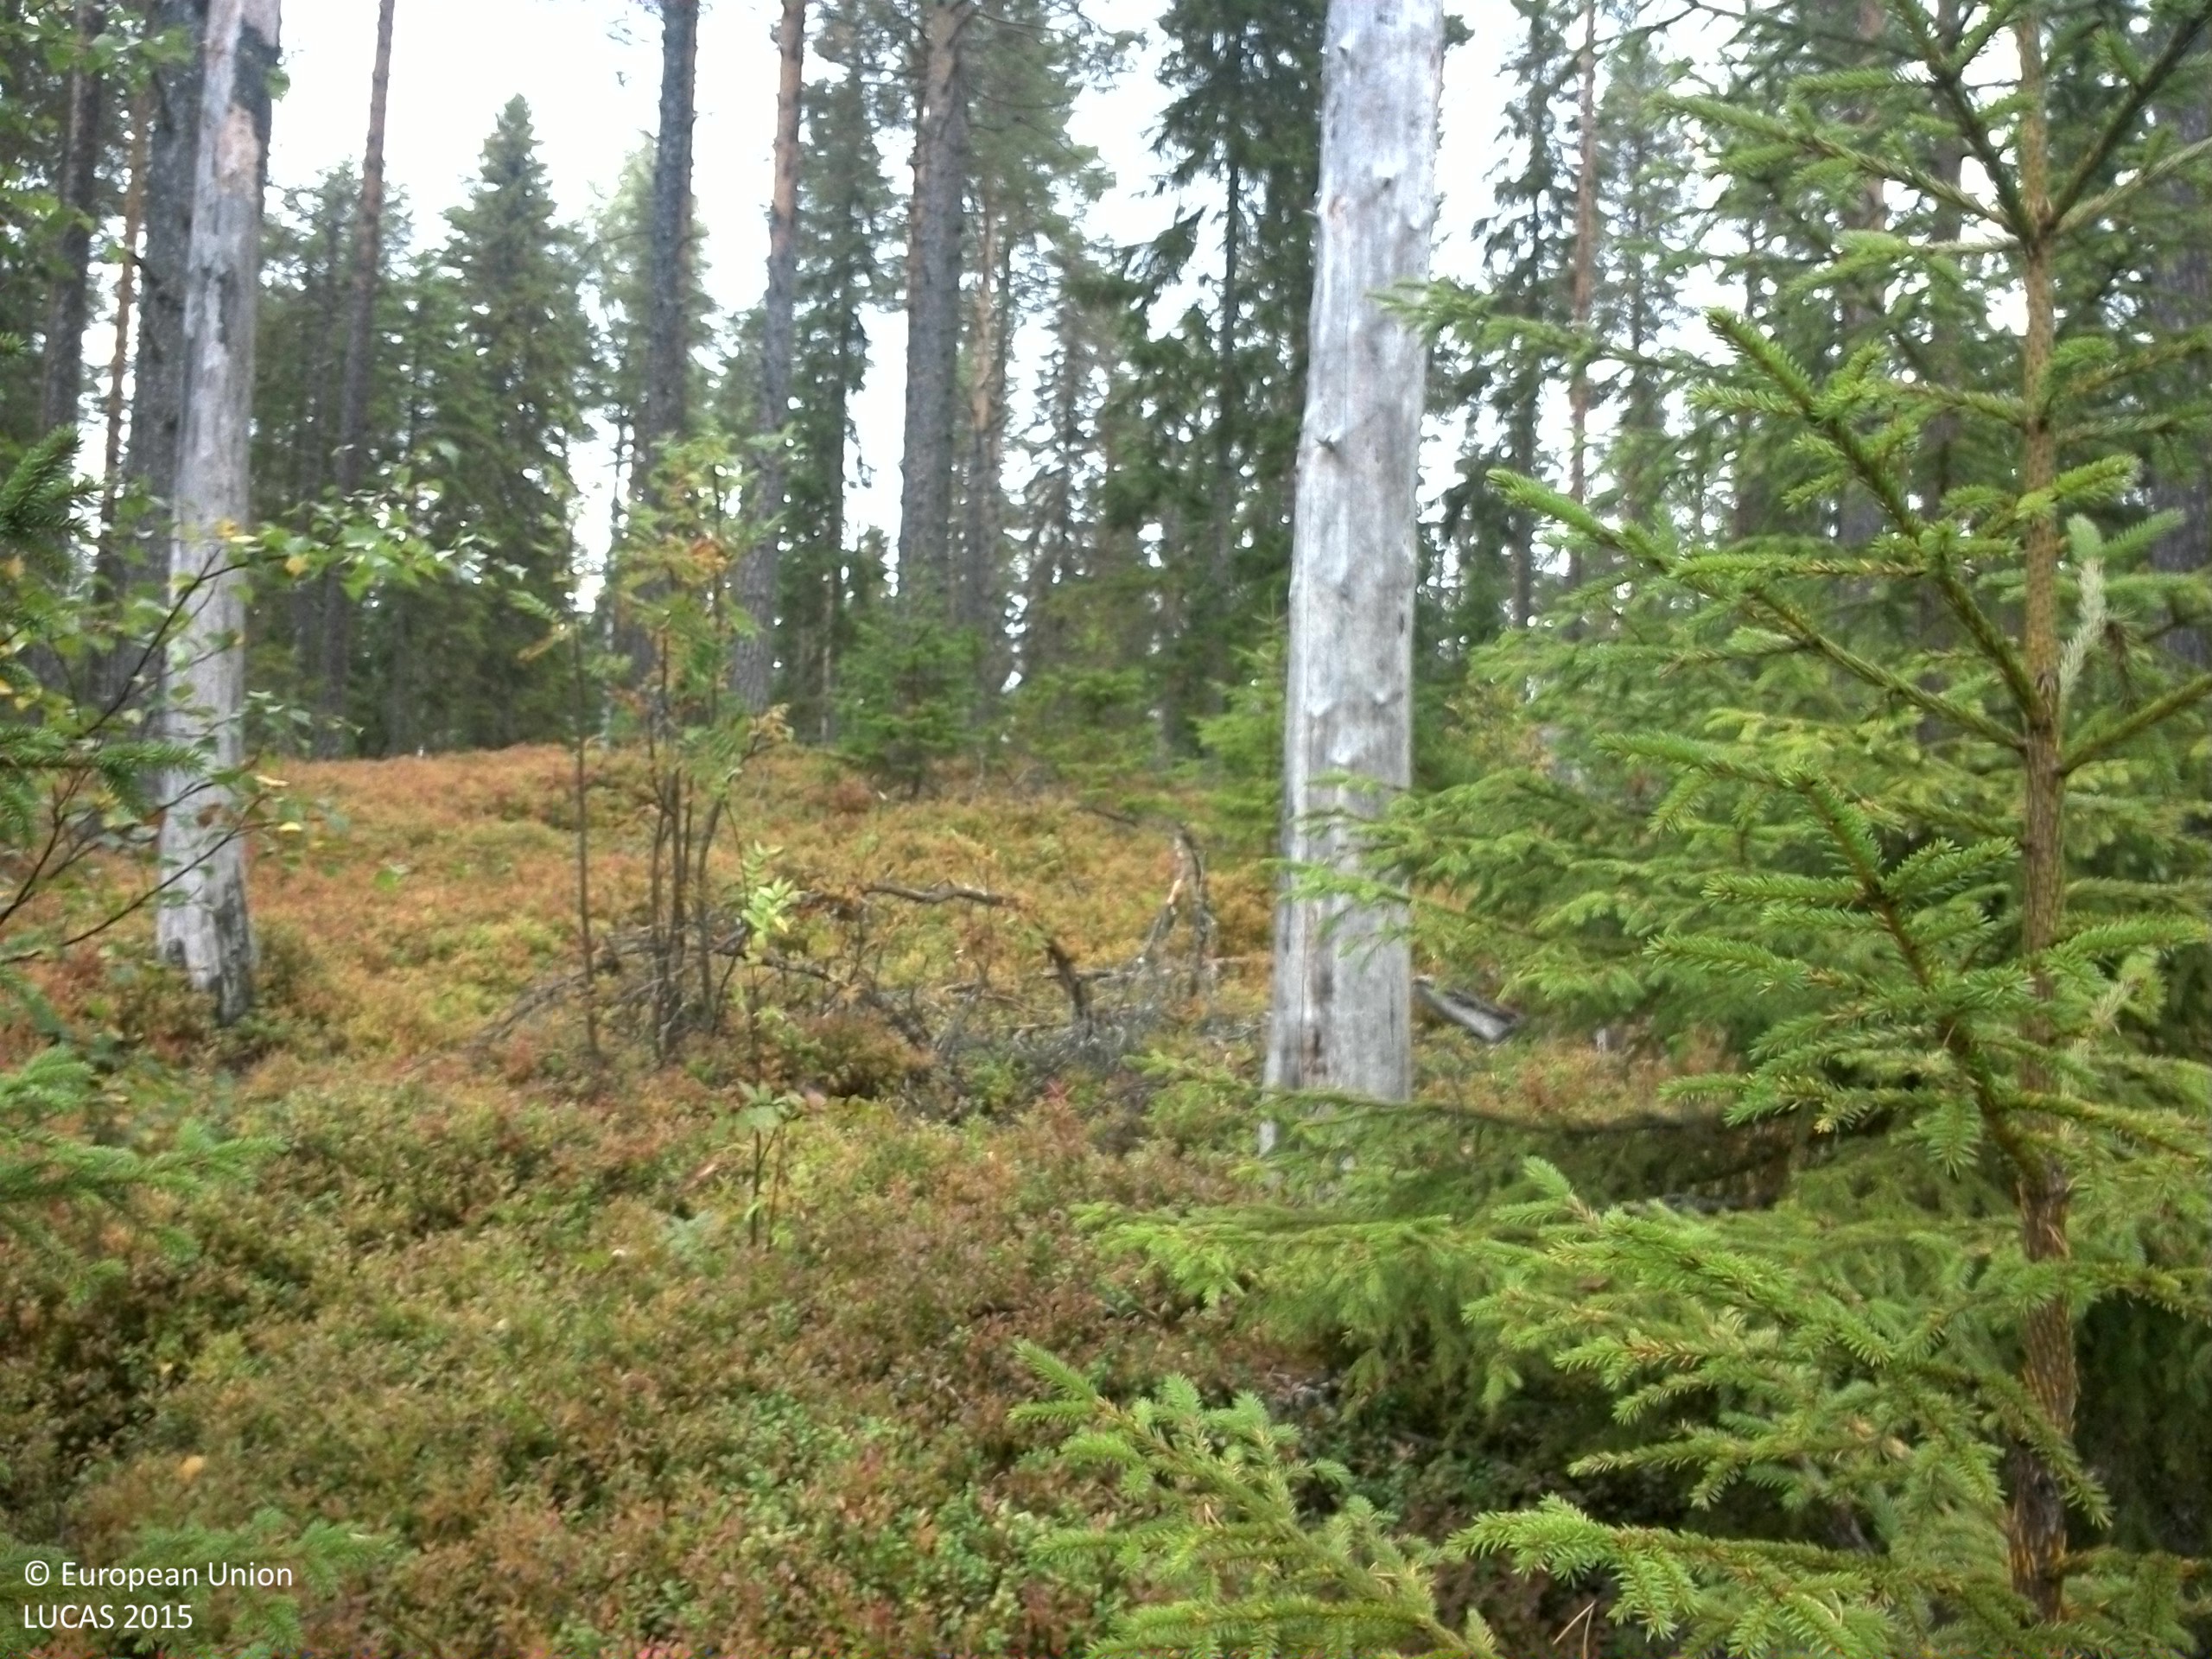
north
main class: Woodland
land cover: Pine dominated coniferous woodland
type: boreal forest
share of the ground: 50 - 75 %
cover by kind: coniferous forest trees 45 %, shrubs 35 %, broadleaved forest trees 10 %, lichens and mosses 10 %
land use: Forestry
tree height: > 5 m
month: September
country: SE
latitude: 63.6785
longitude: 16.2192
